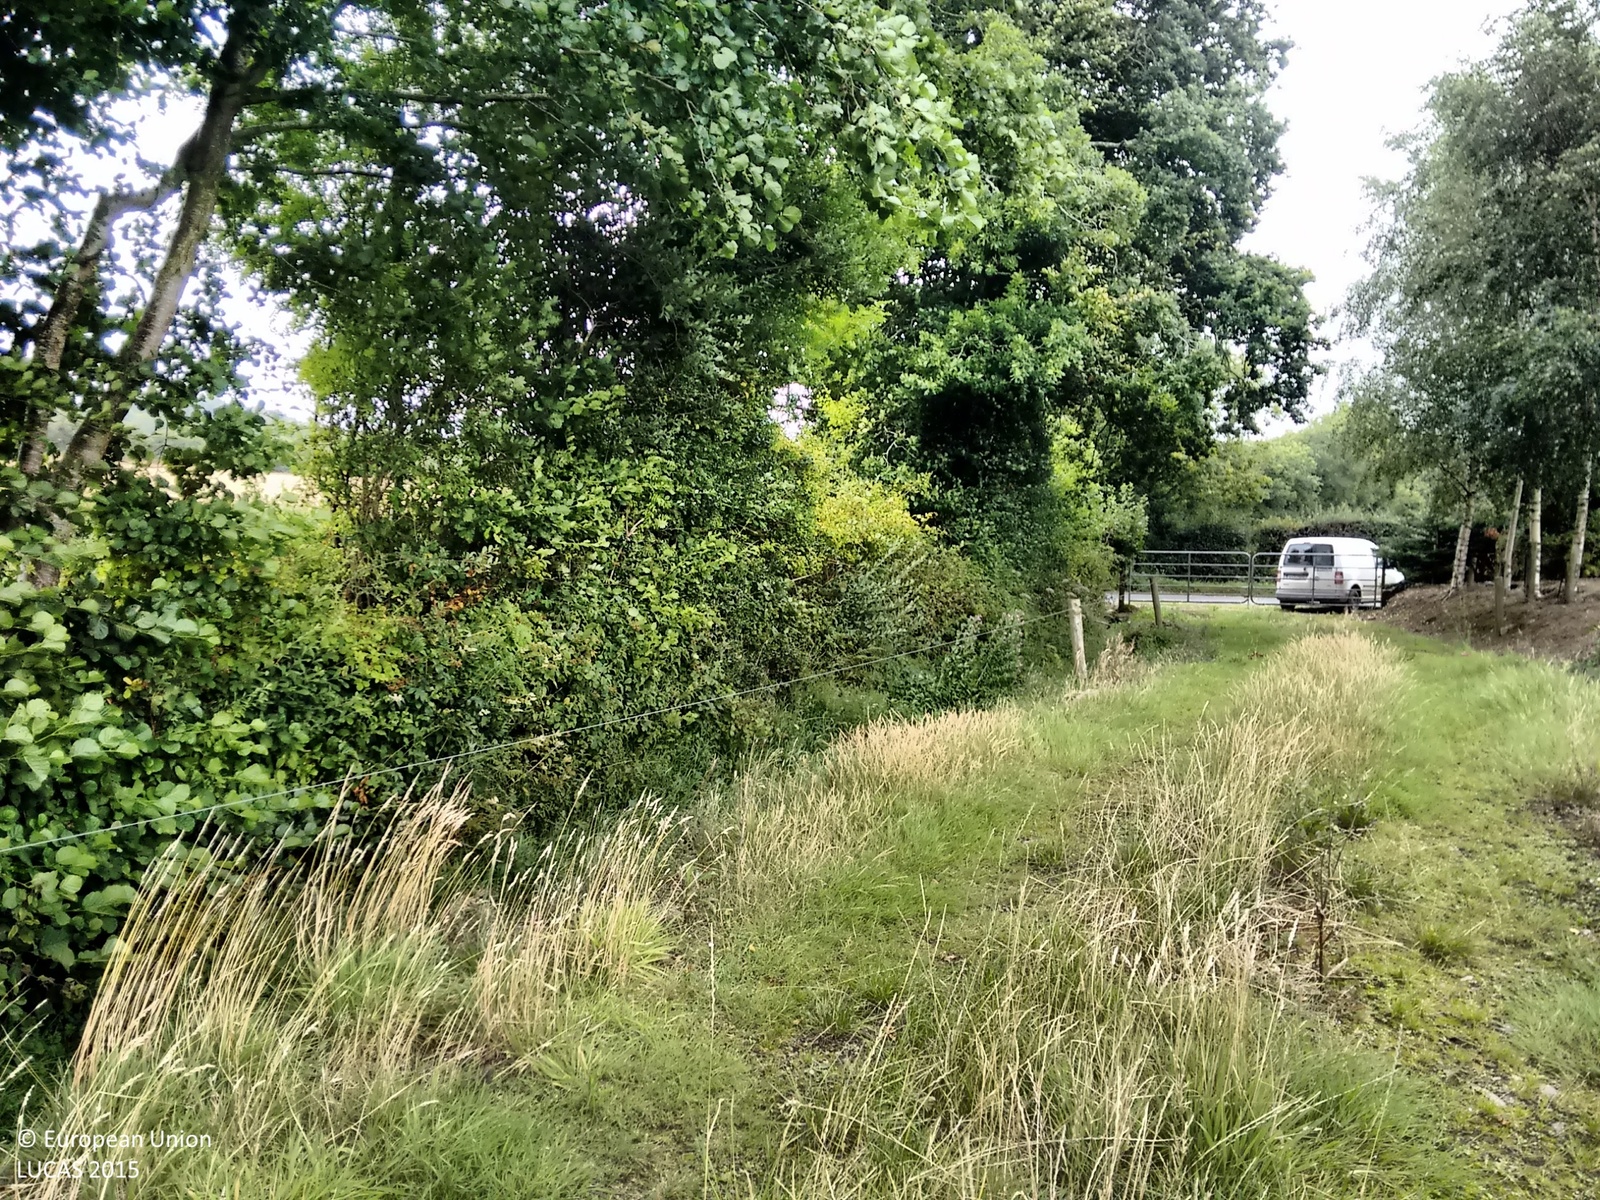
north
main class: Grassland
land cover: Grassland without tree/shrub cover
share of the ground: > 75 %
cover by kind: herbaceous plants 100 %
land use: Agriculture (excluding fallow land and kitchen gardens)
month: August
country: IE
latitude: 52.4472
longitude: -6.5946
